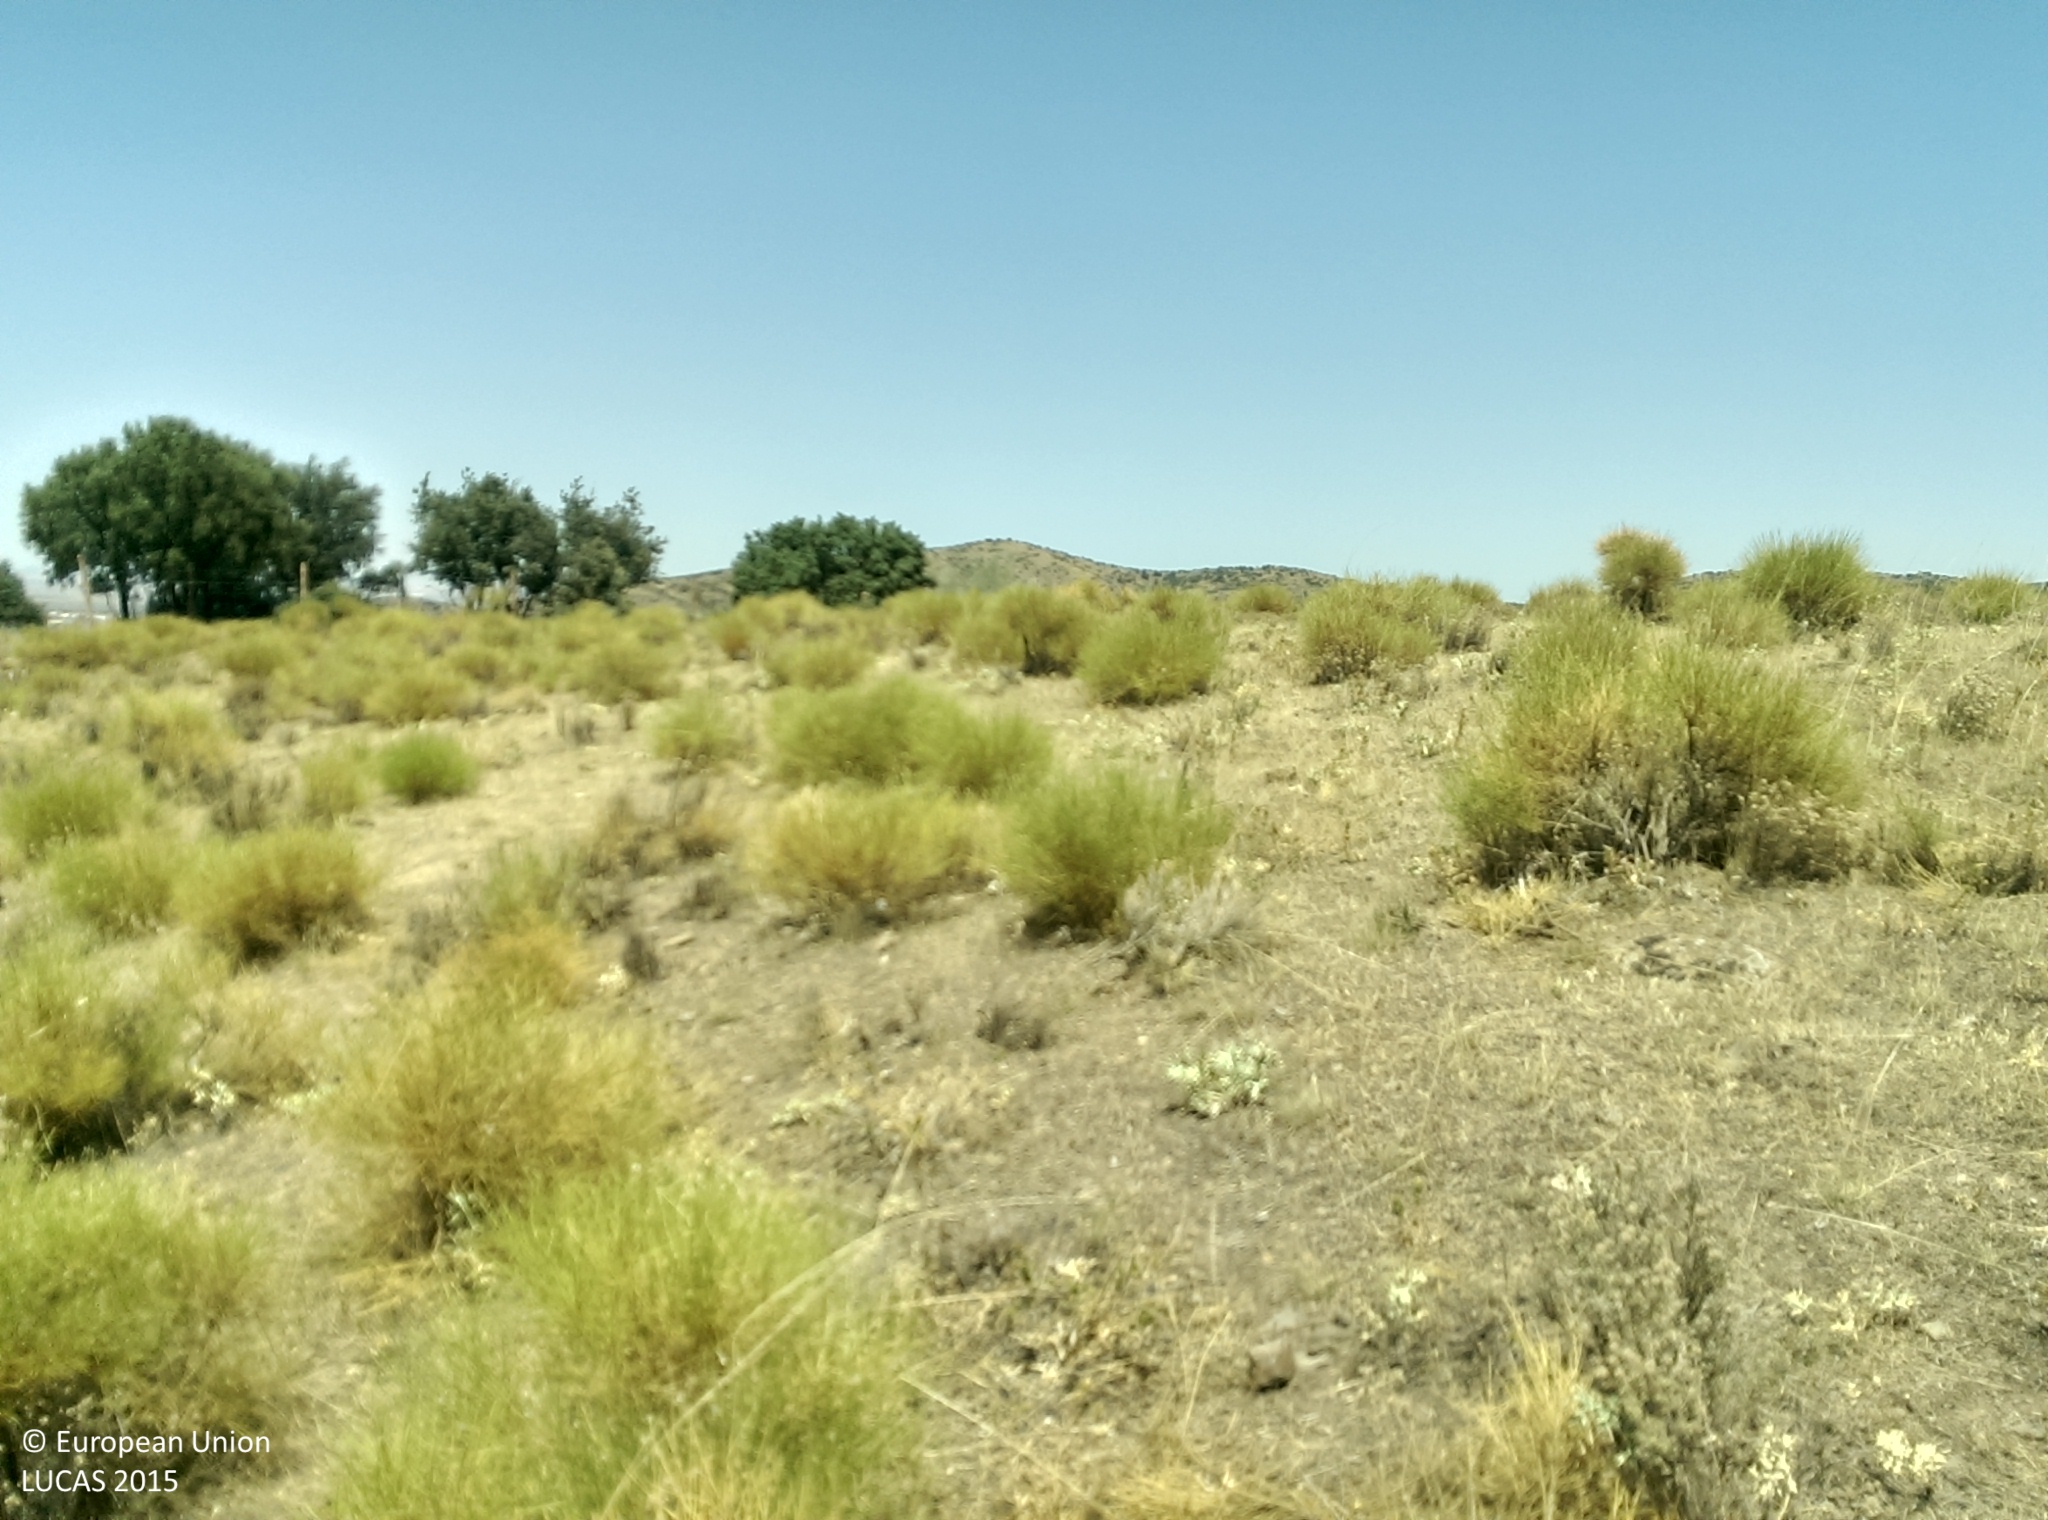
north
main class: Shrubland
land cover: Shrubland without tree cover
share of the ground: 25 - 50 %
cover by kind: shrubs 45 %, herbaceous plants 40 %, unconsolidated bare surface 15 %
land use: Agriculture (excluding fallow land and kitchen gardens)
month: July
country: ES
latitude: 37.2227
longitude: -3.2289
